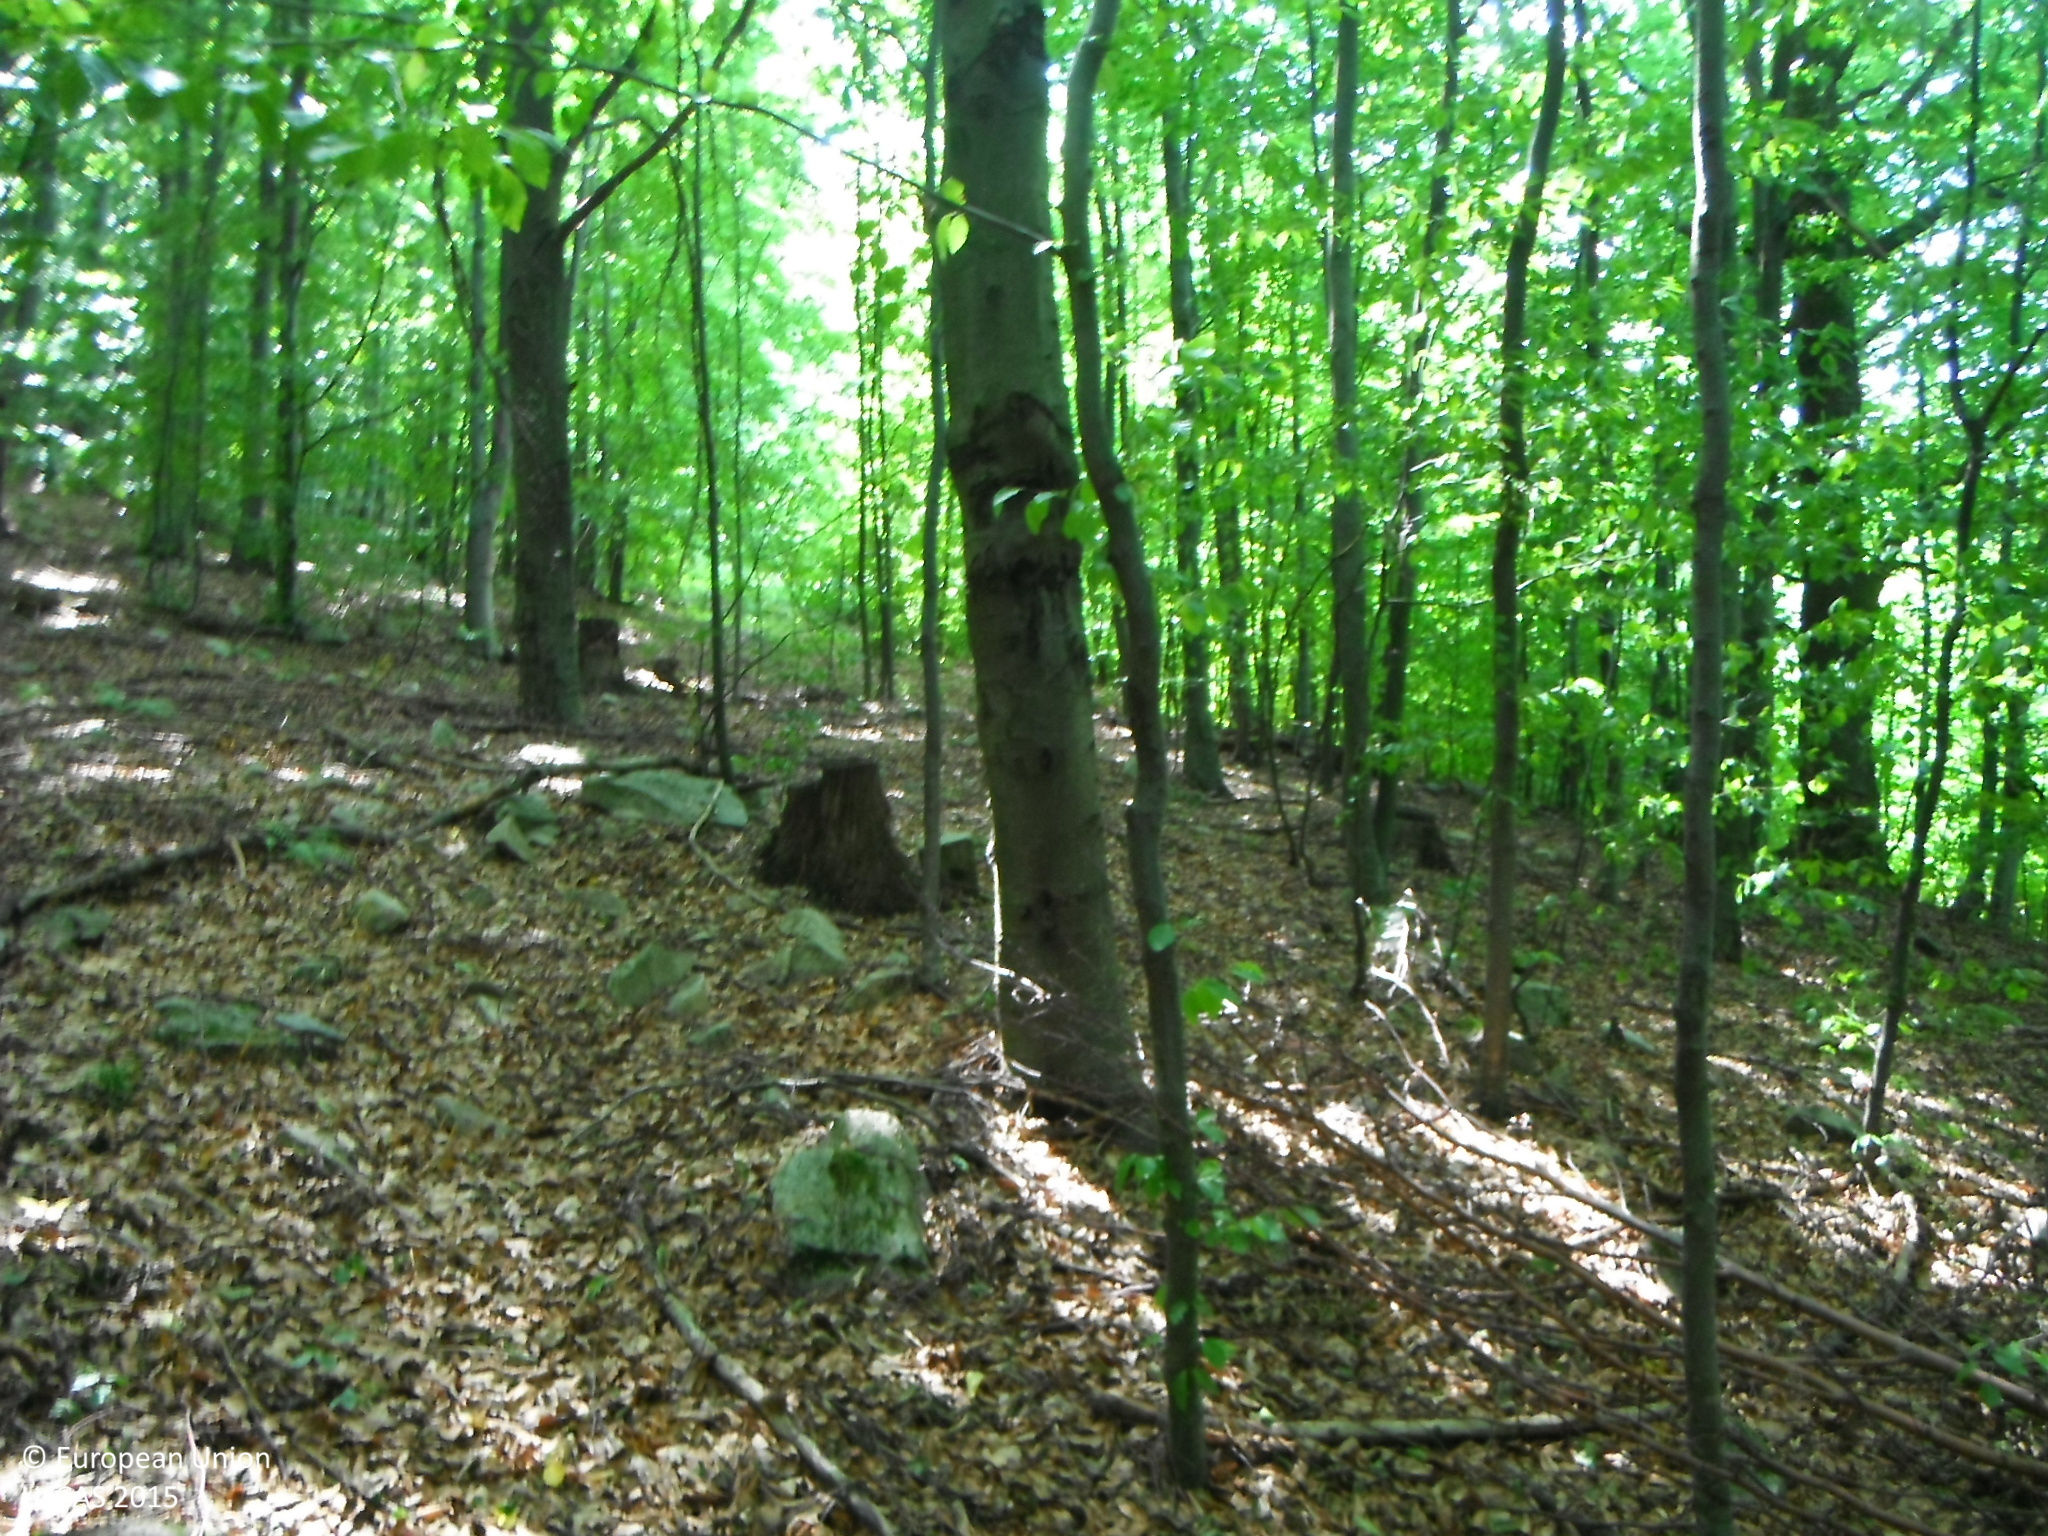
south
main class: Woodland
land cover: Broadleaved woodland
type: beech forest
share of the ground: > 75 %
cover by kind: broadleaved forest trees 100 %
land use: Forestry
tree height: > 5 m
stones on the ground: > 50 %
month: July
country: SK
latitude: 48.7394
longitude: 20.0798
